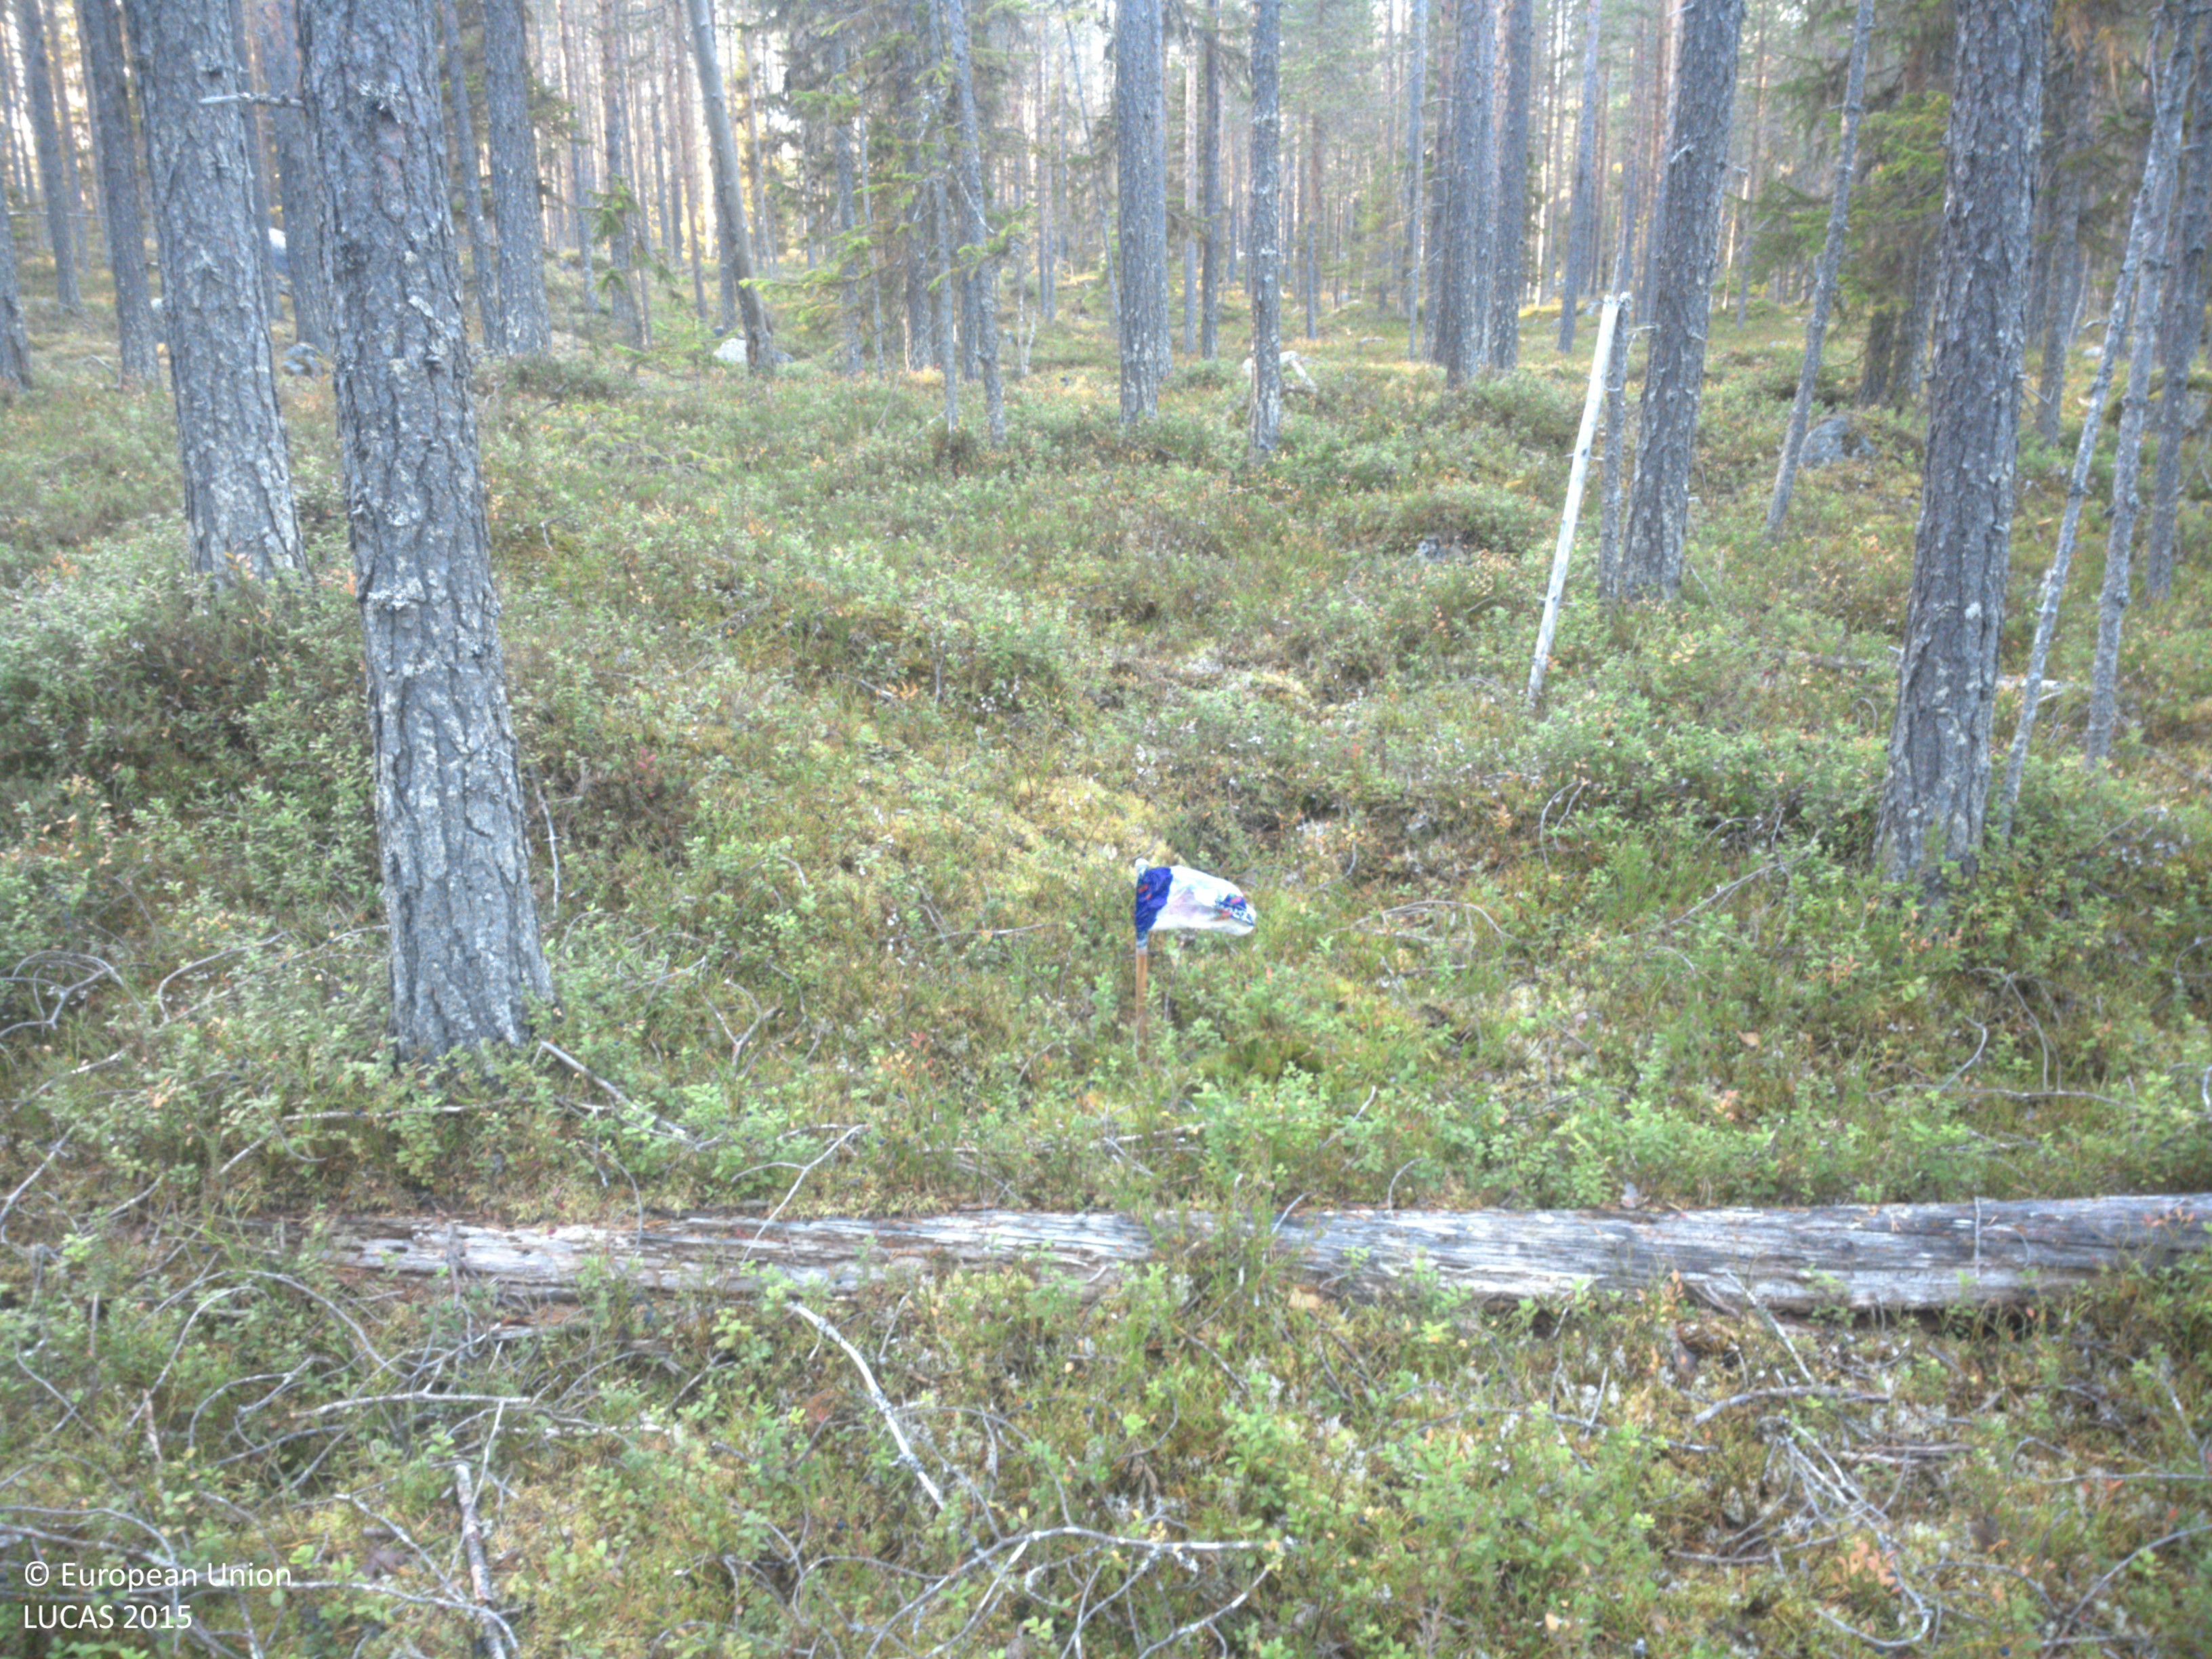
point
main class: Woodland
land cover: Pine dominated coniferous woodland
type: boreal forest
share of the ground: 50 - 75 %
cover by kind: coniferous forest trees 70 %, shrubs 25 %, lichens and mosses 5 %
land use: Forestry
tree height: > 5 m
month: October
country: SE
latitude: 64.8599
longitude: 18.1714
